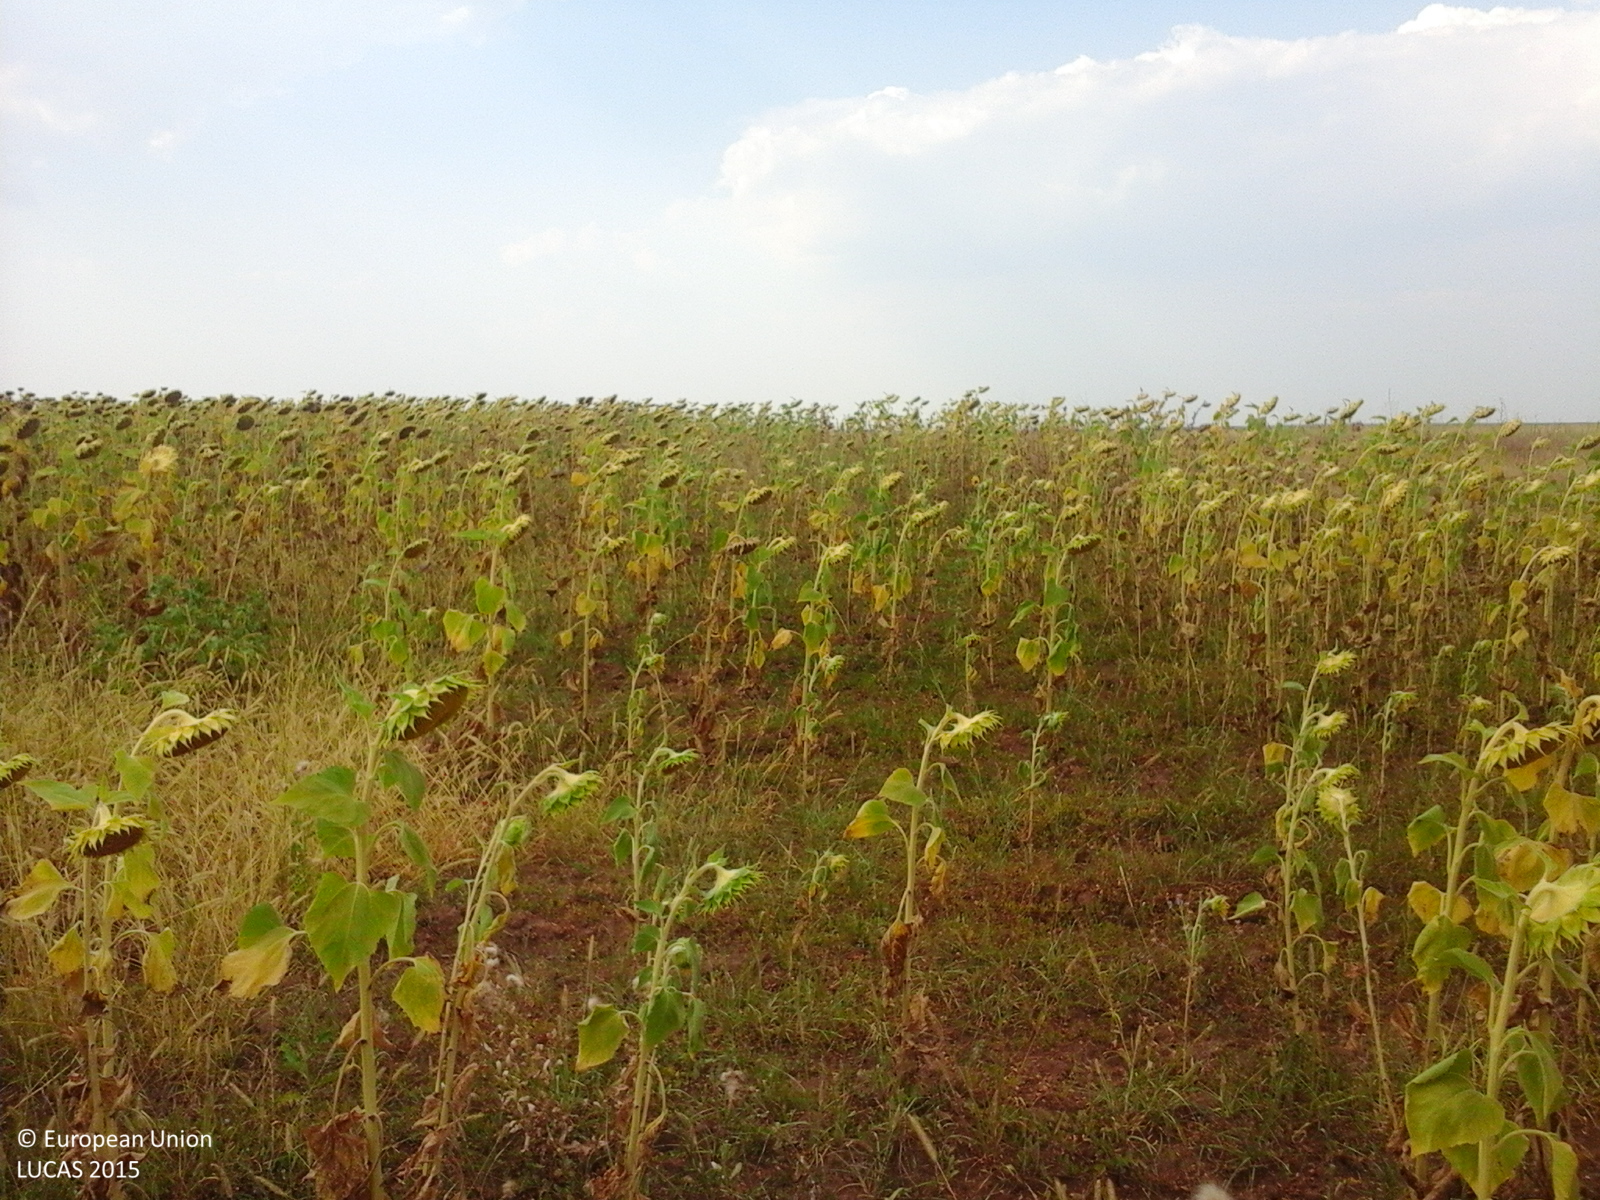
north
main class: Cropland
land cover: Sunflower
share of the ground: > 75 %
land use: Agriculture (excluding fallow land and kitchen gardens)
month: August
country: RO
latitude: 44.3517
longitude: 23.1309
